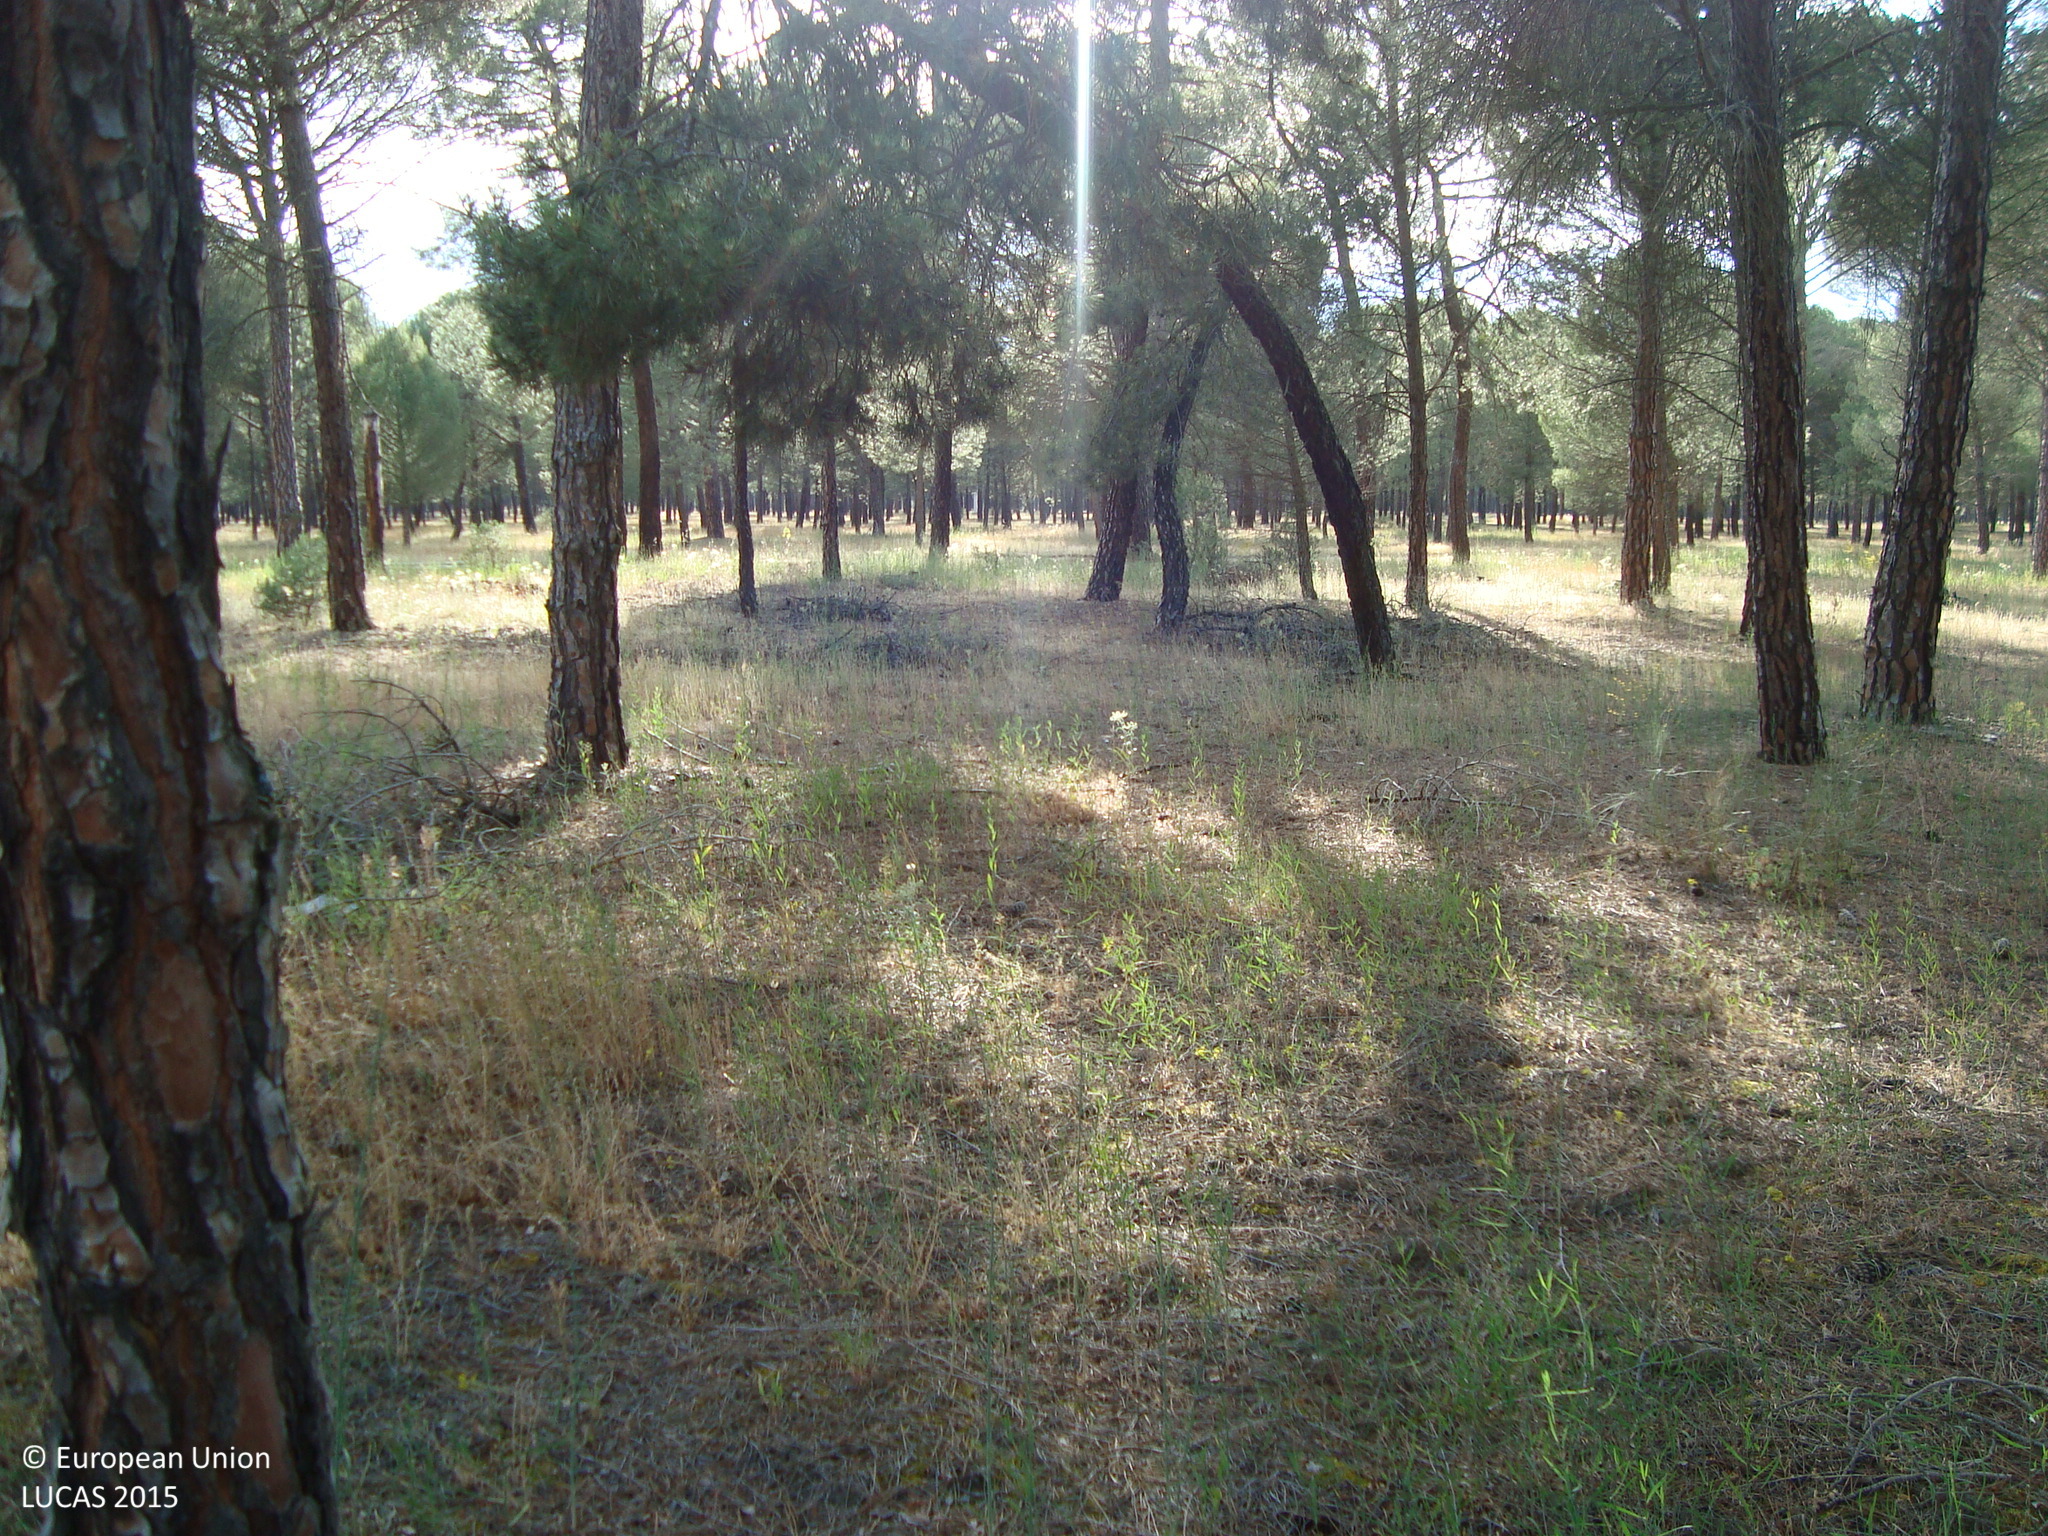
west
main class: Woodland
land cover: Pine dominated coniferous woodland
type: coniferous forest of the mediterranean region
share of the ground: > 75 %
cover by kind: coniferous forest trees 75 %, herbaceous plants 25 %
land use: Forestry
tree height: > 5 m
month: June
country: ES
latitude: 41.3323
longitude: -4.6045
